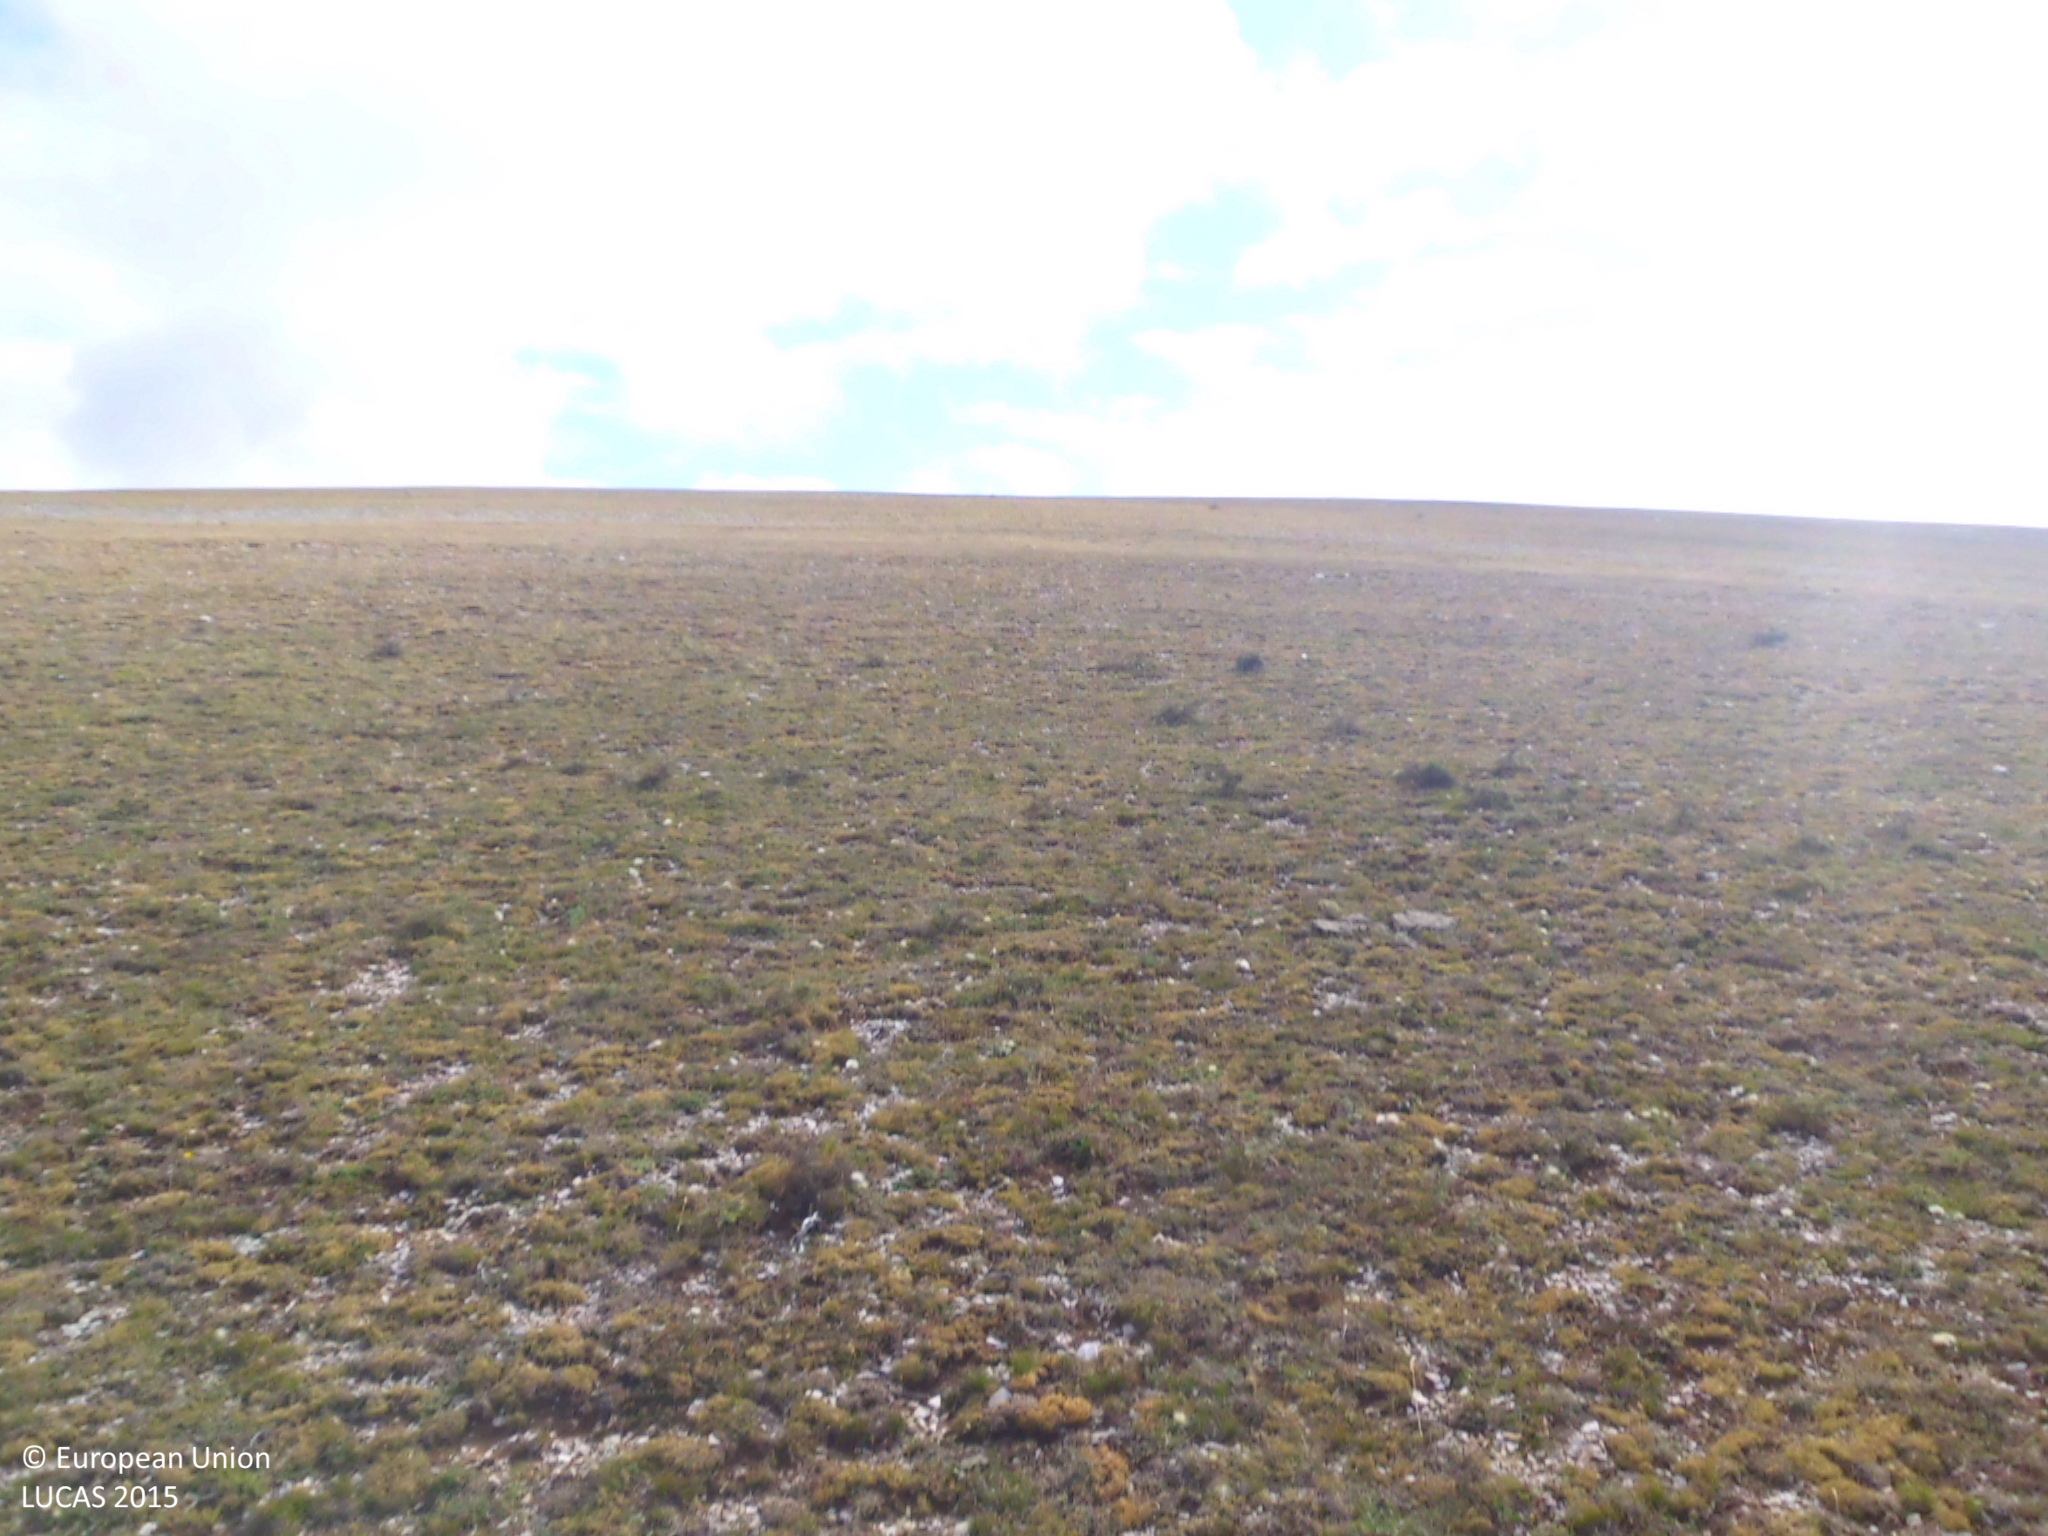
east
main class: Grassland
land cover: Grassland without tree/shrub cover
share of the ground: 50 - 75 %
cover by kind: herbaceous plants 50 %, consolidated bare surface 50 %
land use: Agriculture (excluding fallow land and kitchen gardens)
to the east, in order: Grassland without tree/shrub cover
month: July
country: ES
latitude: 42.6946
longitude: -4.0462
